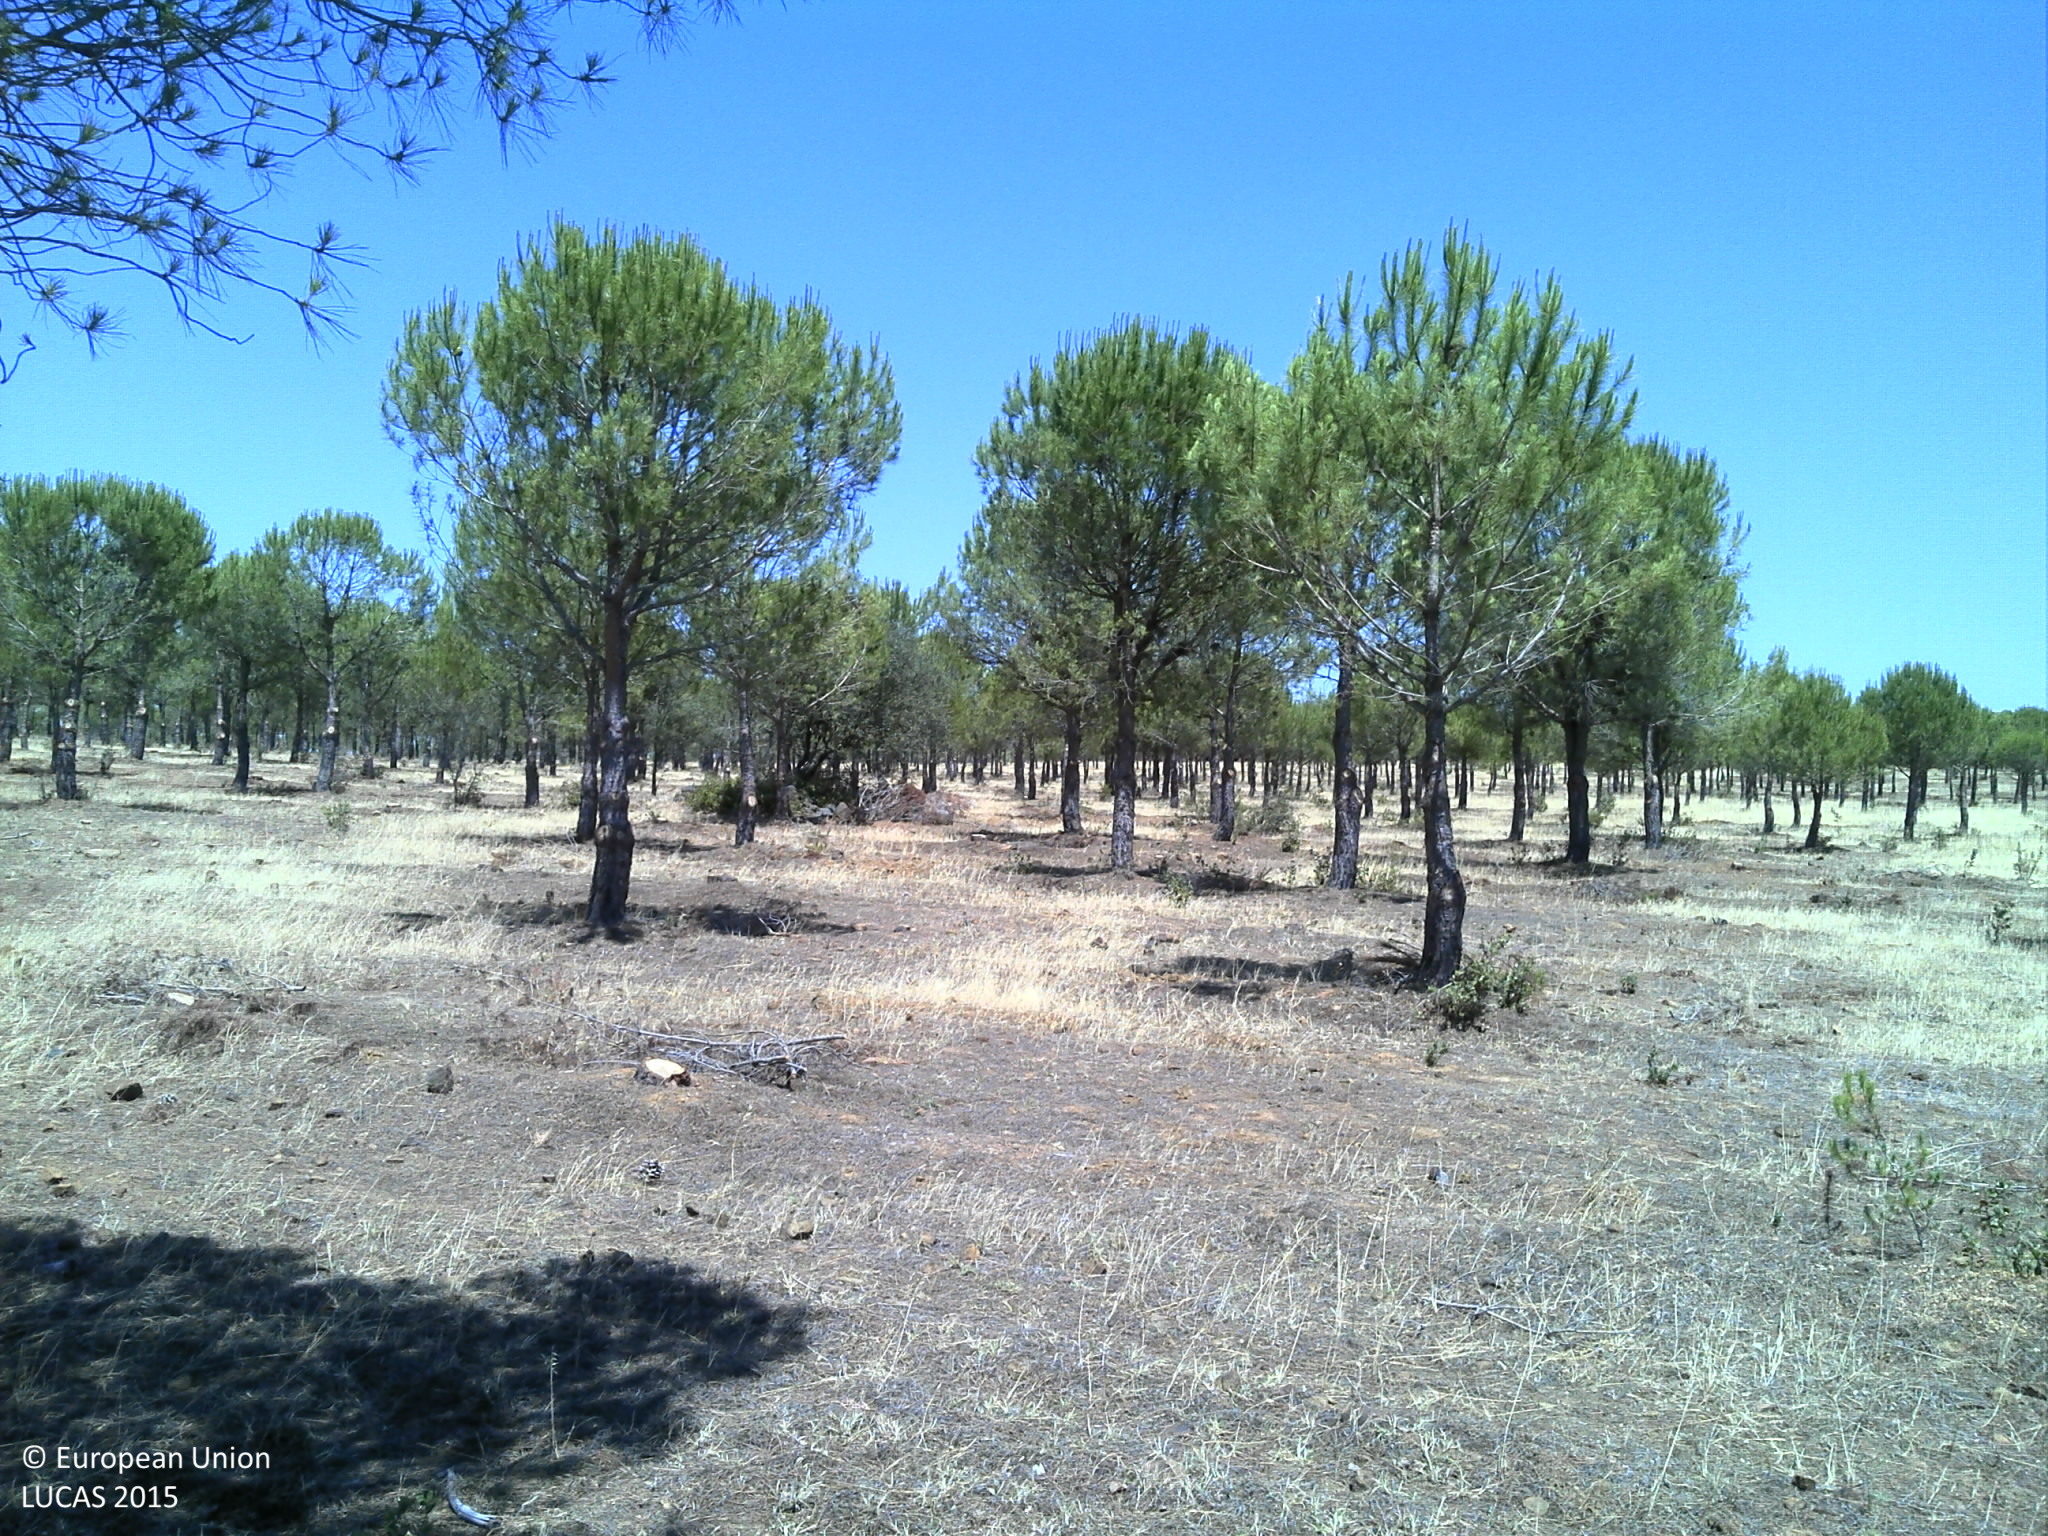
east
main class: Woodland
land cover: Pine dominated coniferous woodland
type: coniferous forest of the mediterranean region
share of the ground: 25 - 50 %
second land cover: Grassland without tree/shrub cover
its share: 10 - 25 %
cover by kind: unconsolidated bare surface 50 %, coniferous forest trees 40 %, herbaceous plants 10 %
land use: Forestry
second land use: Agriculture (excluding fallow land and kitchen gardens)
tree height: > 5 m
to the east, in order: Pine dominated coniferous woodland; Grassland without tree/shrub cover; Pine dominated coniferous woodland
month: June
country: PT
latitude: 38.1381
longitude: -8.0266
